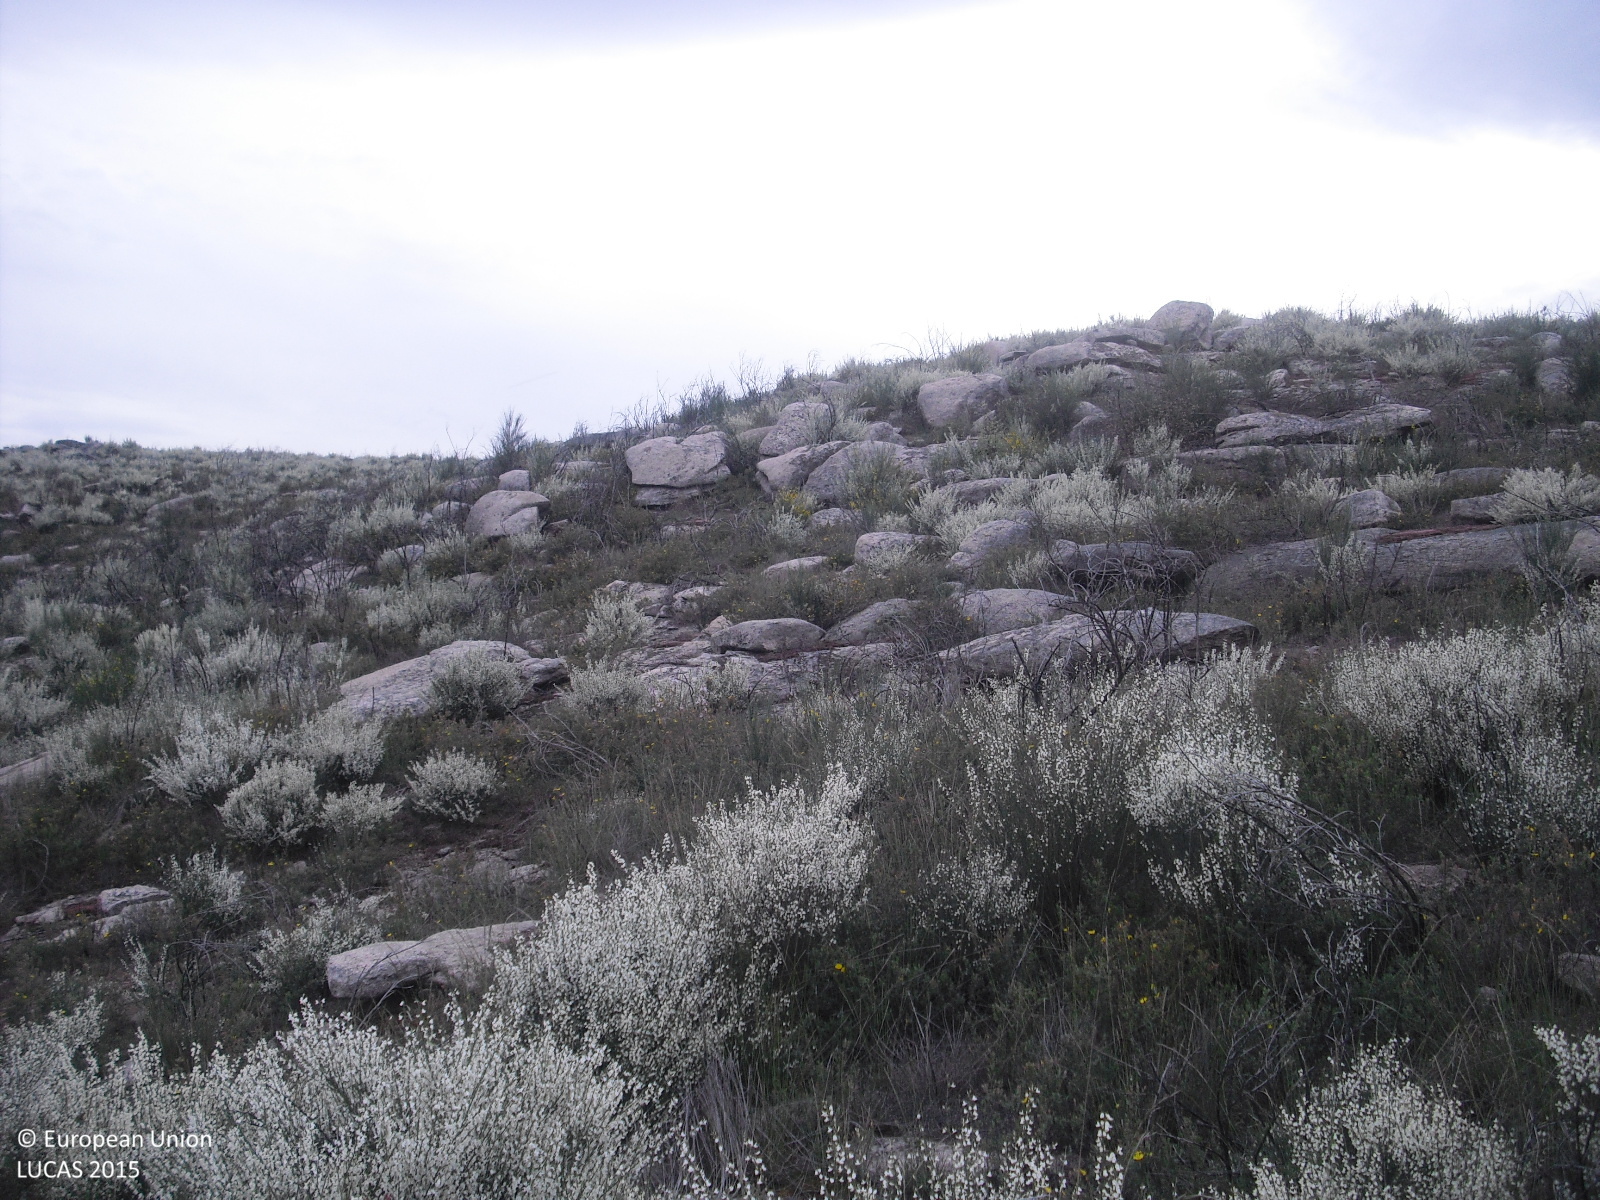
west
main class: Shrubland
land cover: Shrubland without tree cover
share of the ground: 50 - 75 %
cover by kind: shrubs 90 %, consolidated bare surface 10 %
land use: Semi-natural and natural areas not in use
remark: Burnt area
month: April
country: ES
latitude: 41.9090
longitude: -7.6049
